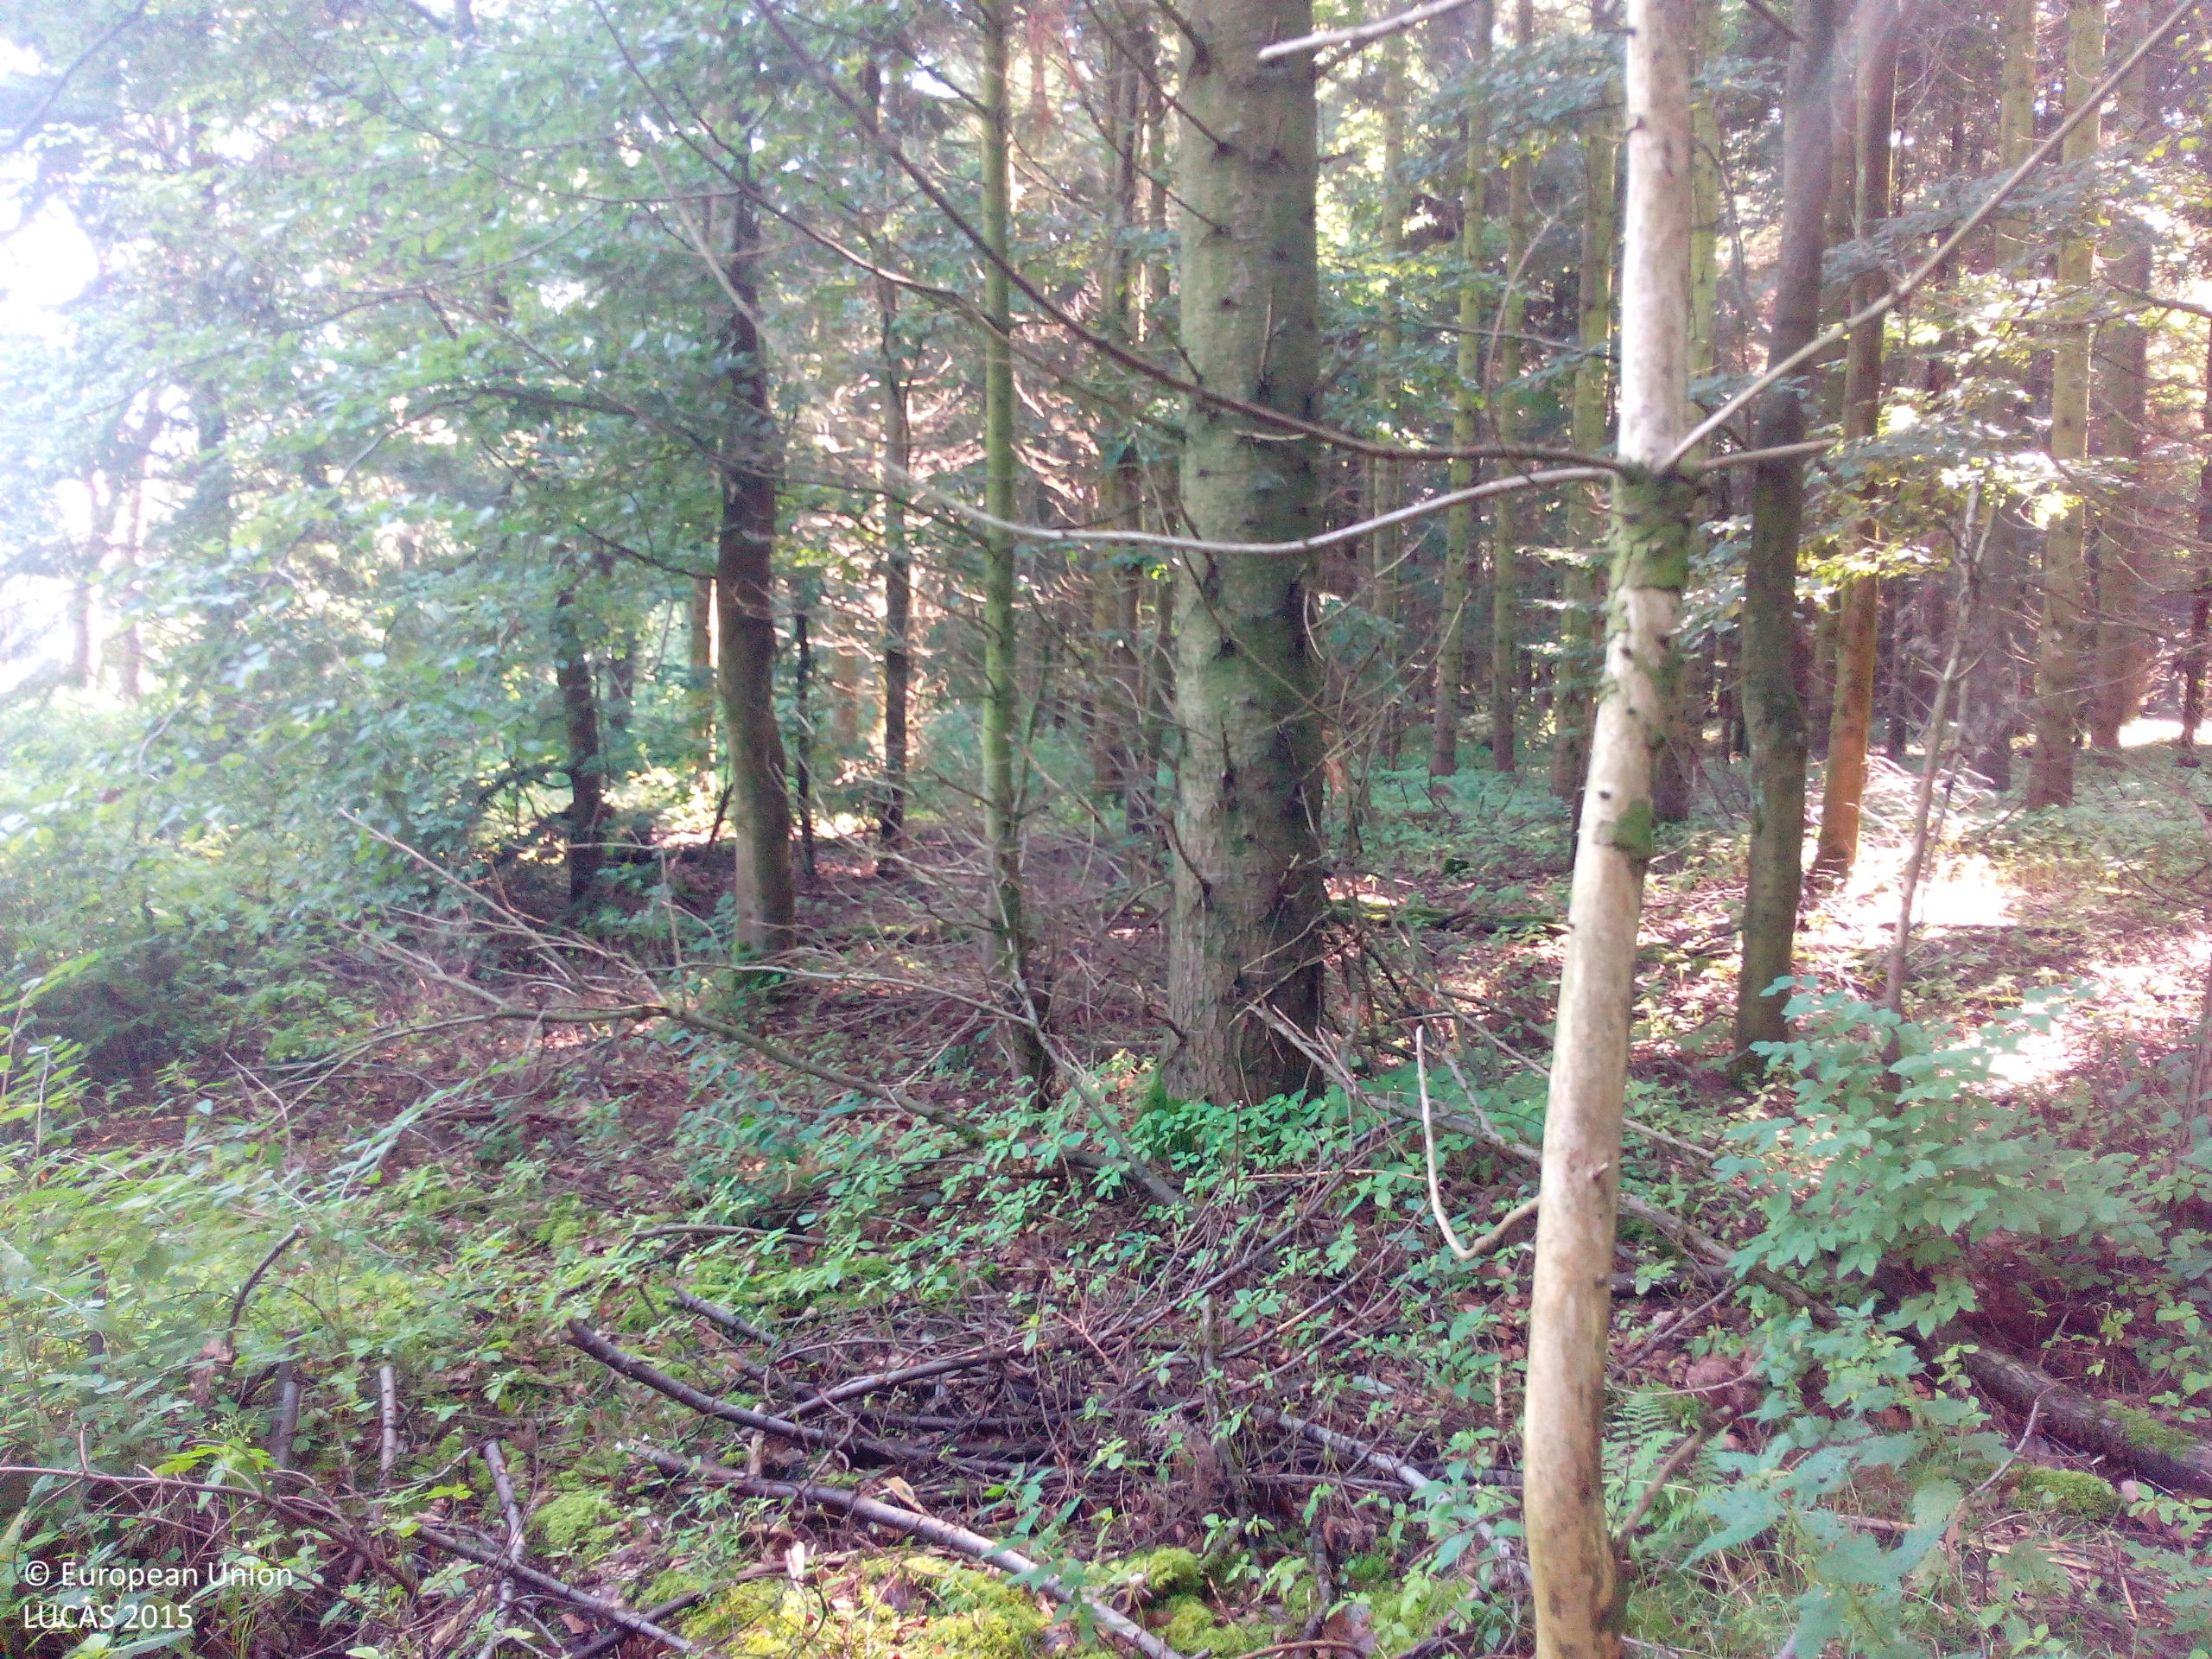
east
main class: Woodland
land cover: Other mixed woodland
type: hemiboreal forest and nemoral coniferous forest and mixed broadleaved-coniferous forest
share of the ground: > 75 %
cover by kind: coniferous forest trees 75 %, broadleaved forest trees 25 %
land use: Forestry
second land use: Amenities, museums, leisure
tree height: > 5 m
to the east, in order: Other mixed woodland; Broadleaved woodland; Pine dominated coniferous woodland
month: August
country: DE
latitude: 53.8152
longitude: 9.8330
